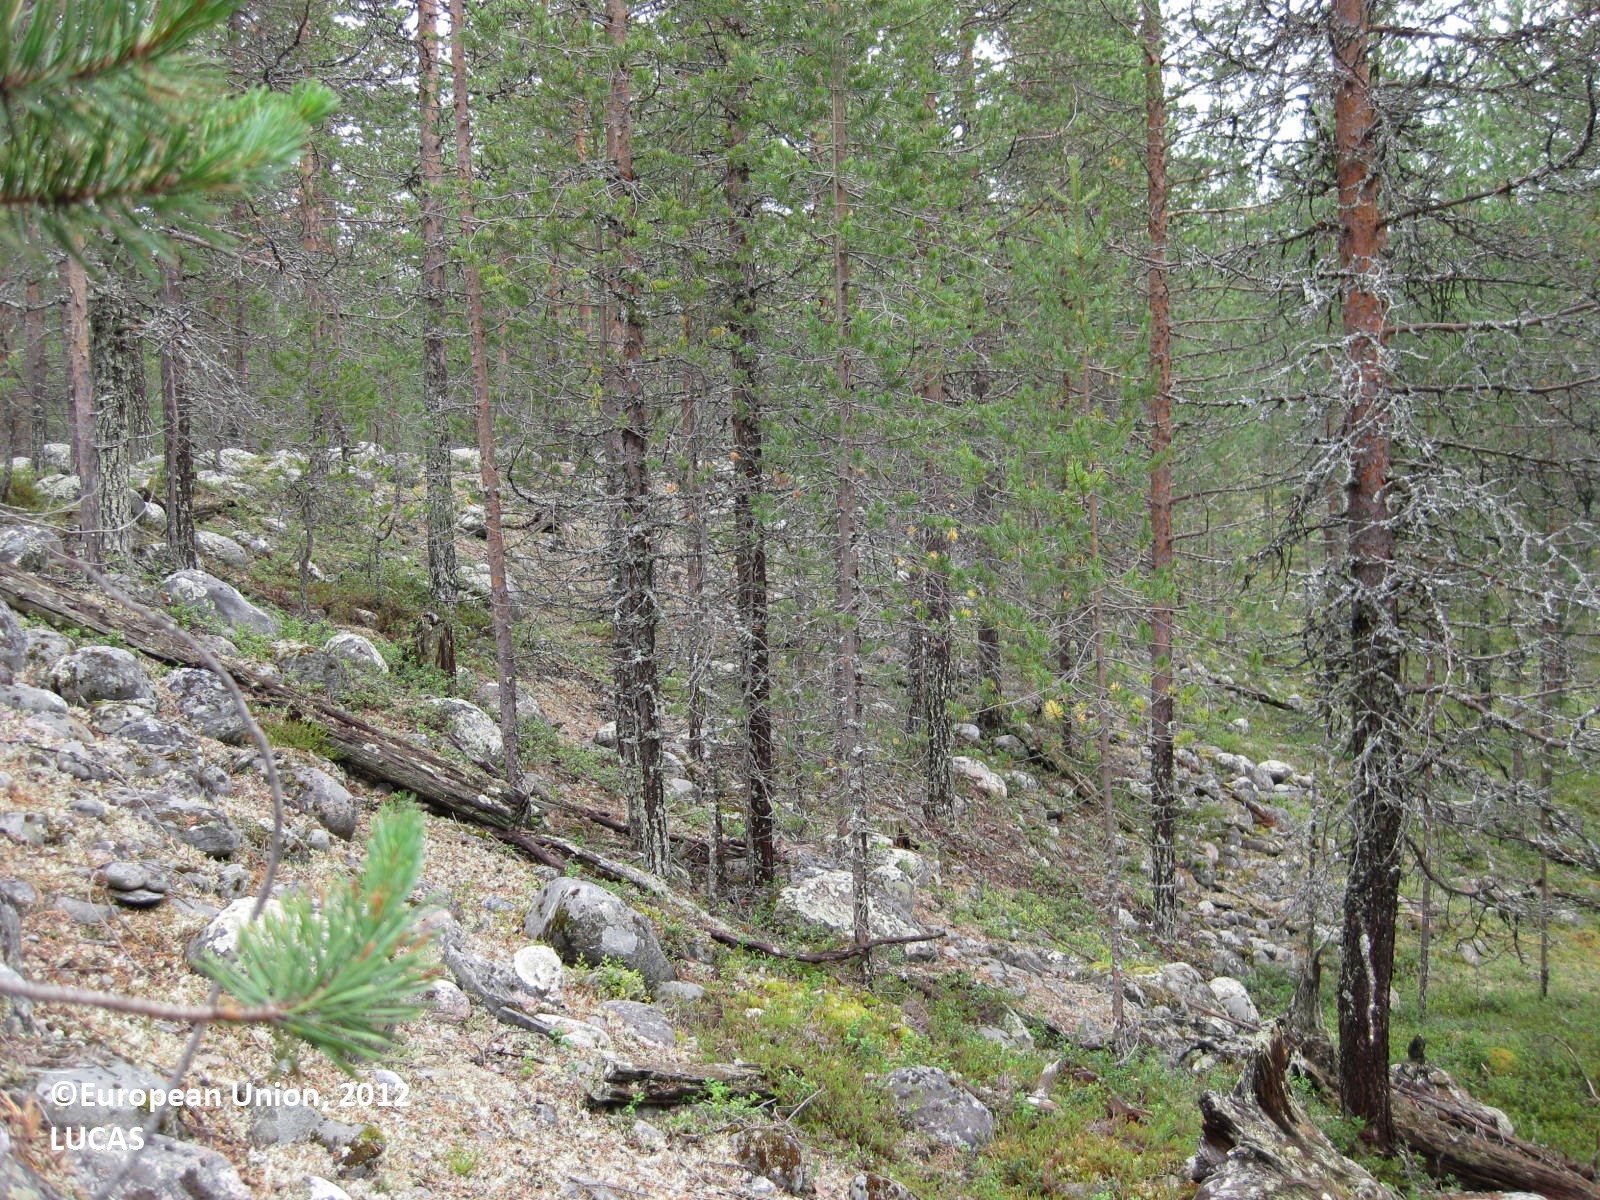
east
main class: Woodland
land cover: Pine dominated coniferous woodland
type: boreal forest
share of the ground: 50 - 75 %
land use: Forestry
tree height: > 5 m
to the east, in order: Pine dominated coniferous woodland; Electric lines; Pine dominated coniferous woodland; Shrubland without tree cover; Electric lines; Shrubland without tree cover; Pine dominated coniferous woodland
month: August
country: FI
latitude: 66.0073
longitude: 28.1483
